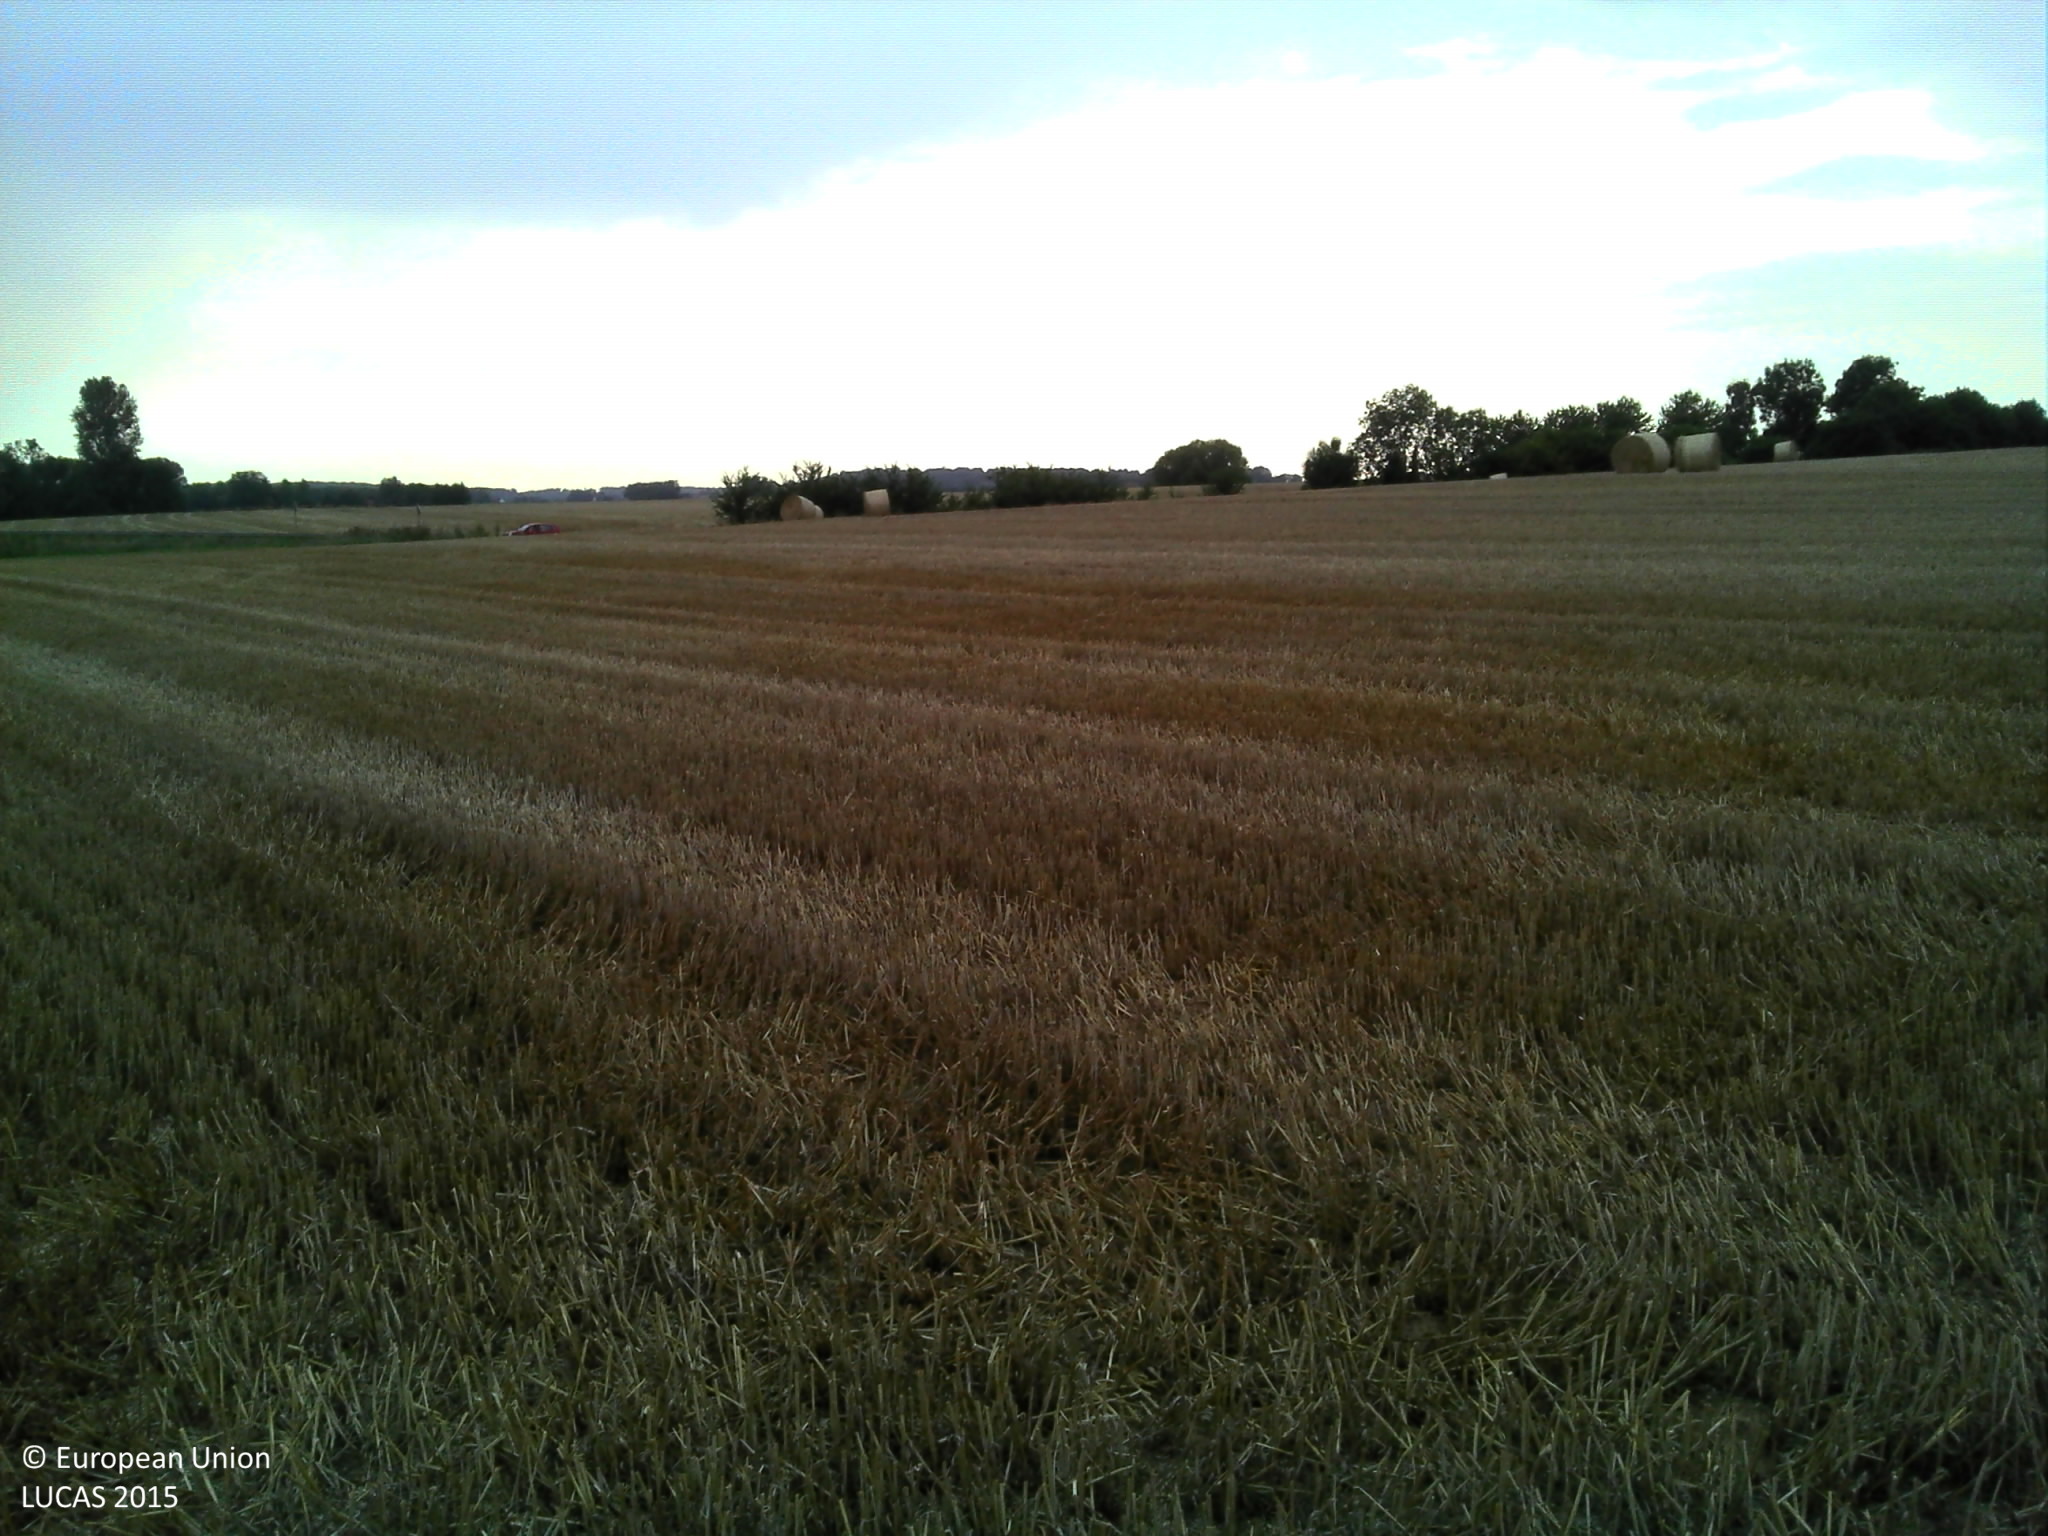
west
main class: Cropland
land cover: Common wheat
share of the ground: < 10 %
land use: Agriculture (excluding fallow land and kitchen gardens)
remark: Harvested field
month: August
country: BE
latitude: 50.6623
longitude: 3.7544
